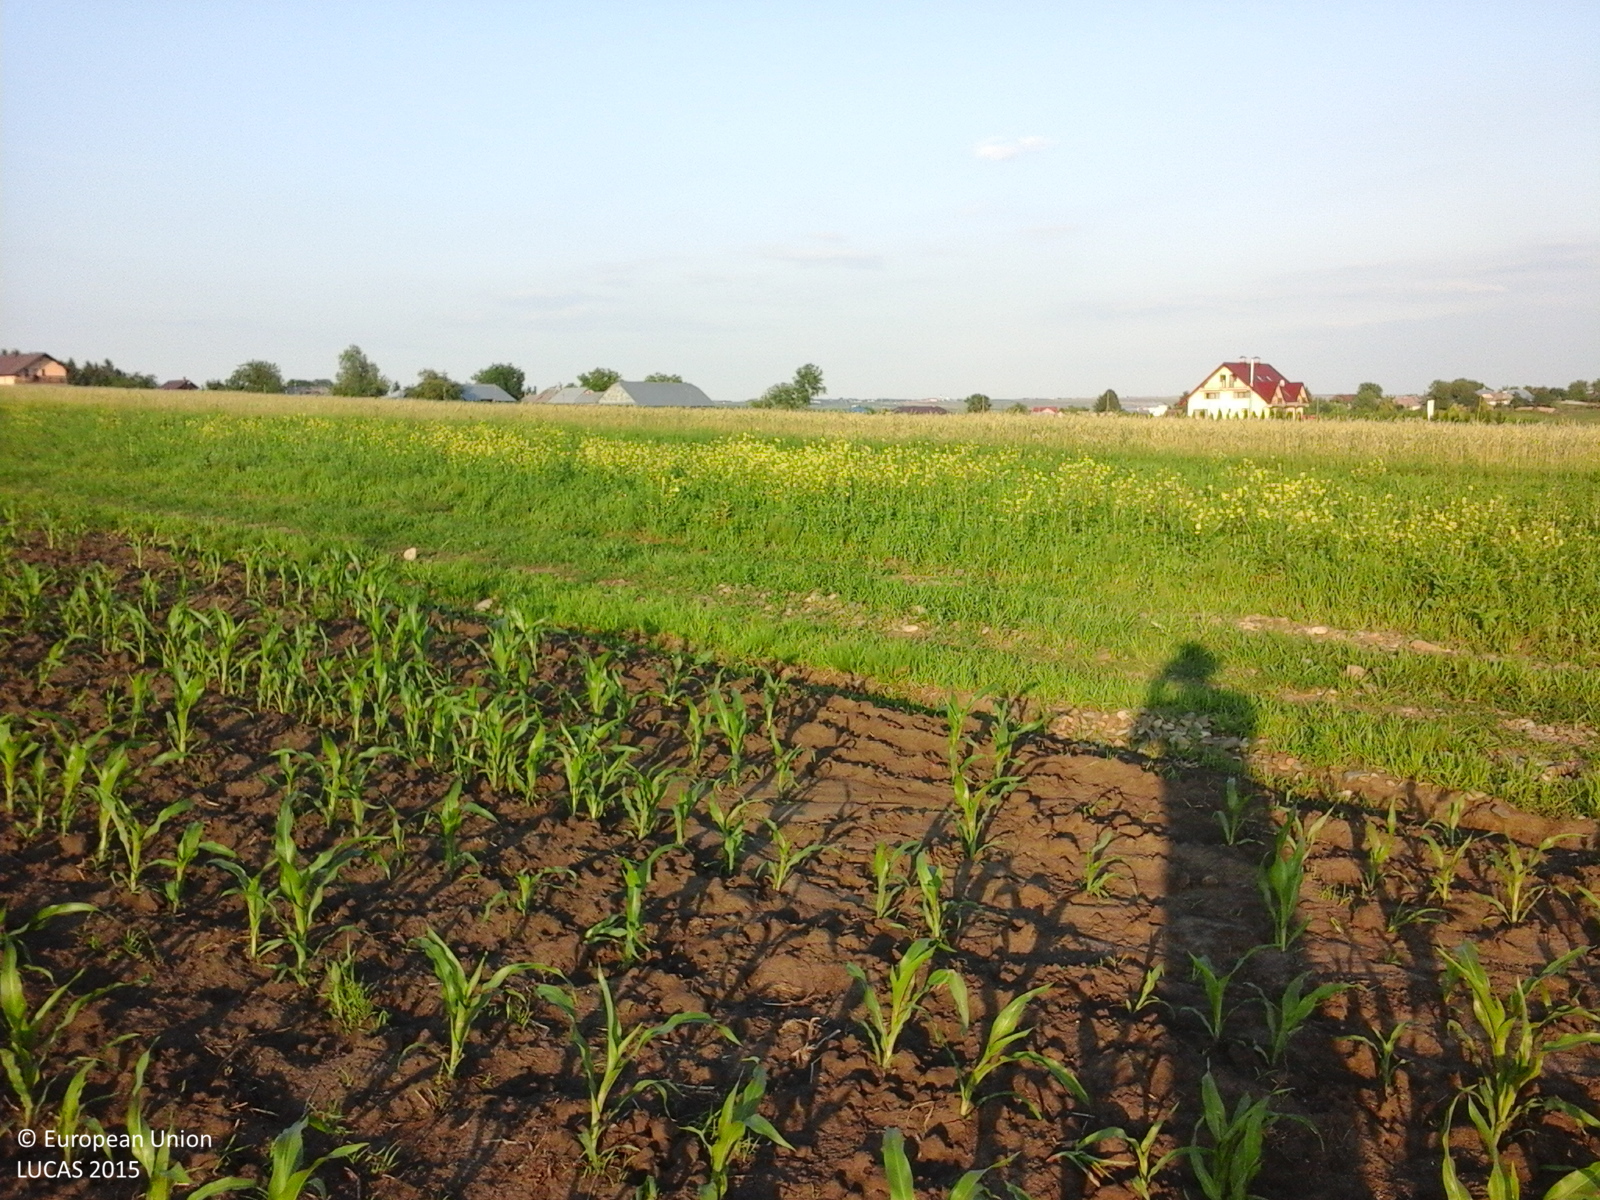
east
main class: Cropland
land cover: Maize
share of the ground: 25 - 50 %
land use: Agriculture (excluding fallow land and kitchen gardens)
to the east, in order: Maize; Tracks; Lucerne; Oats; Maize; Lucerne; Clovers; Potatoes; Maize
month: June
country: RO
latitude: 47.5997
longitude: 26.2151
